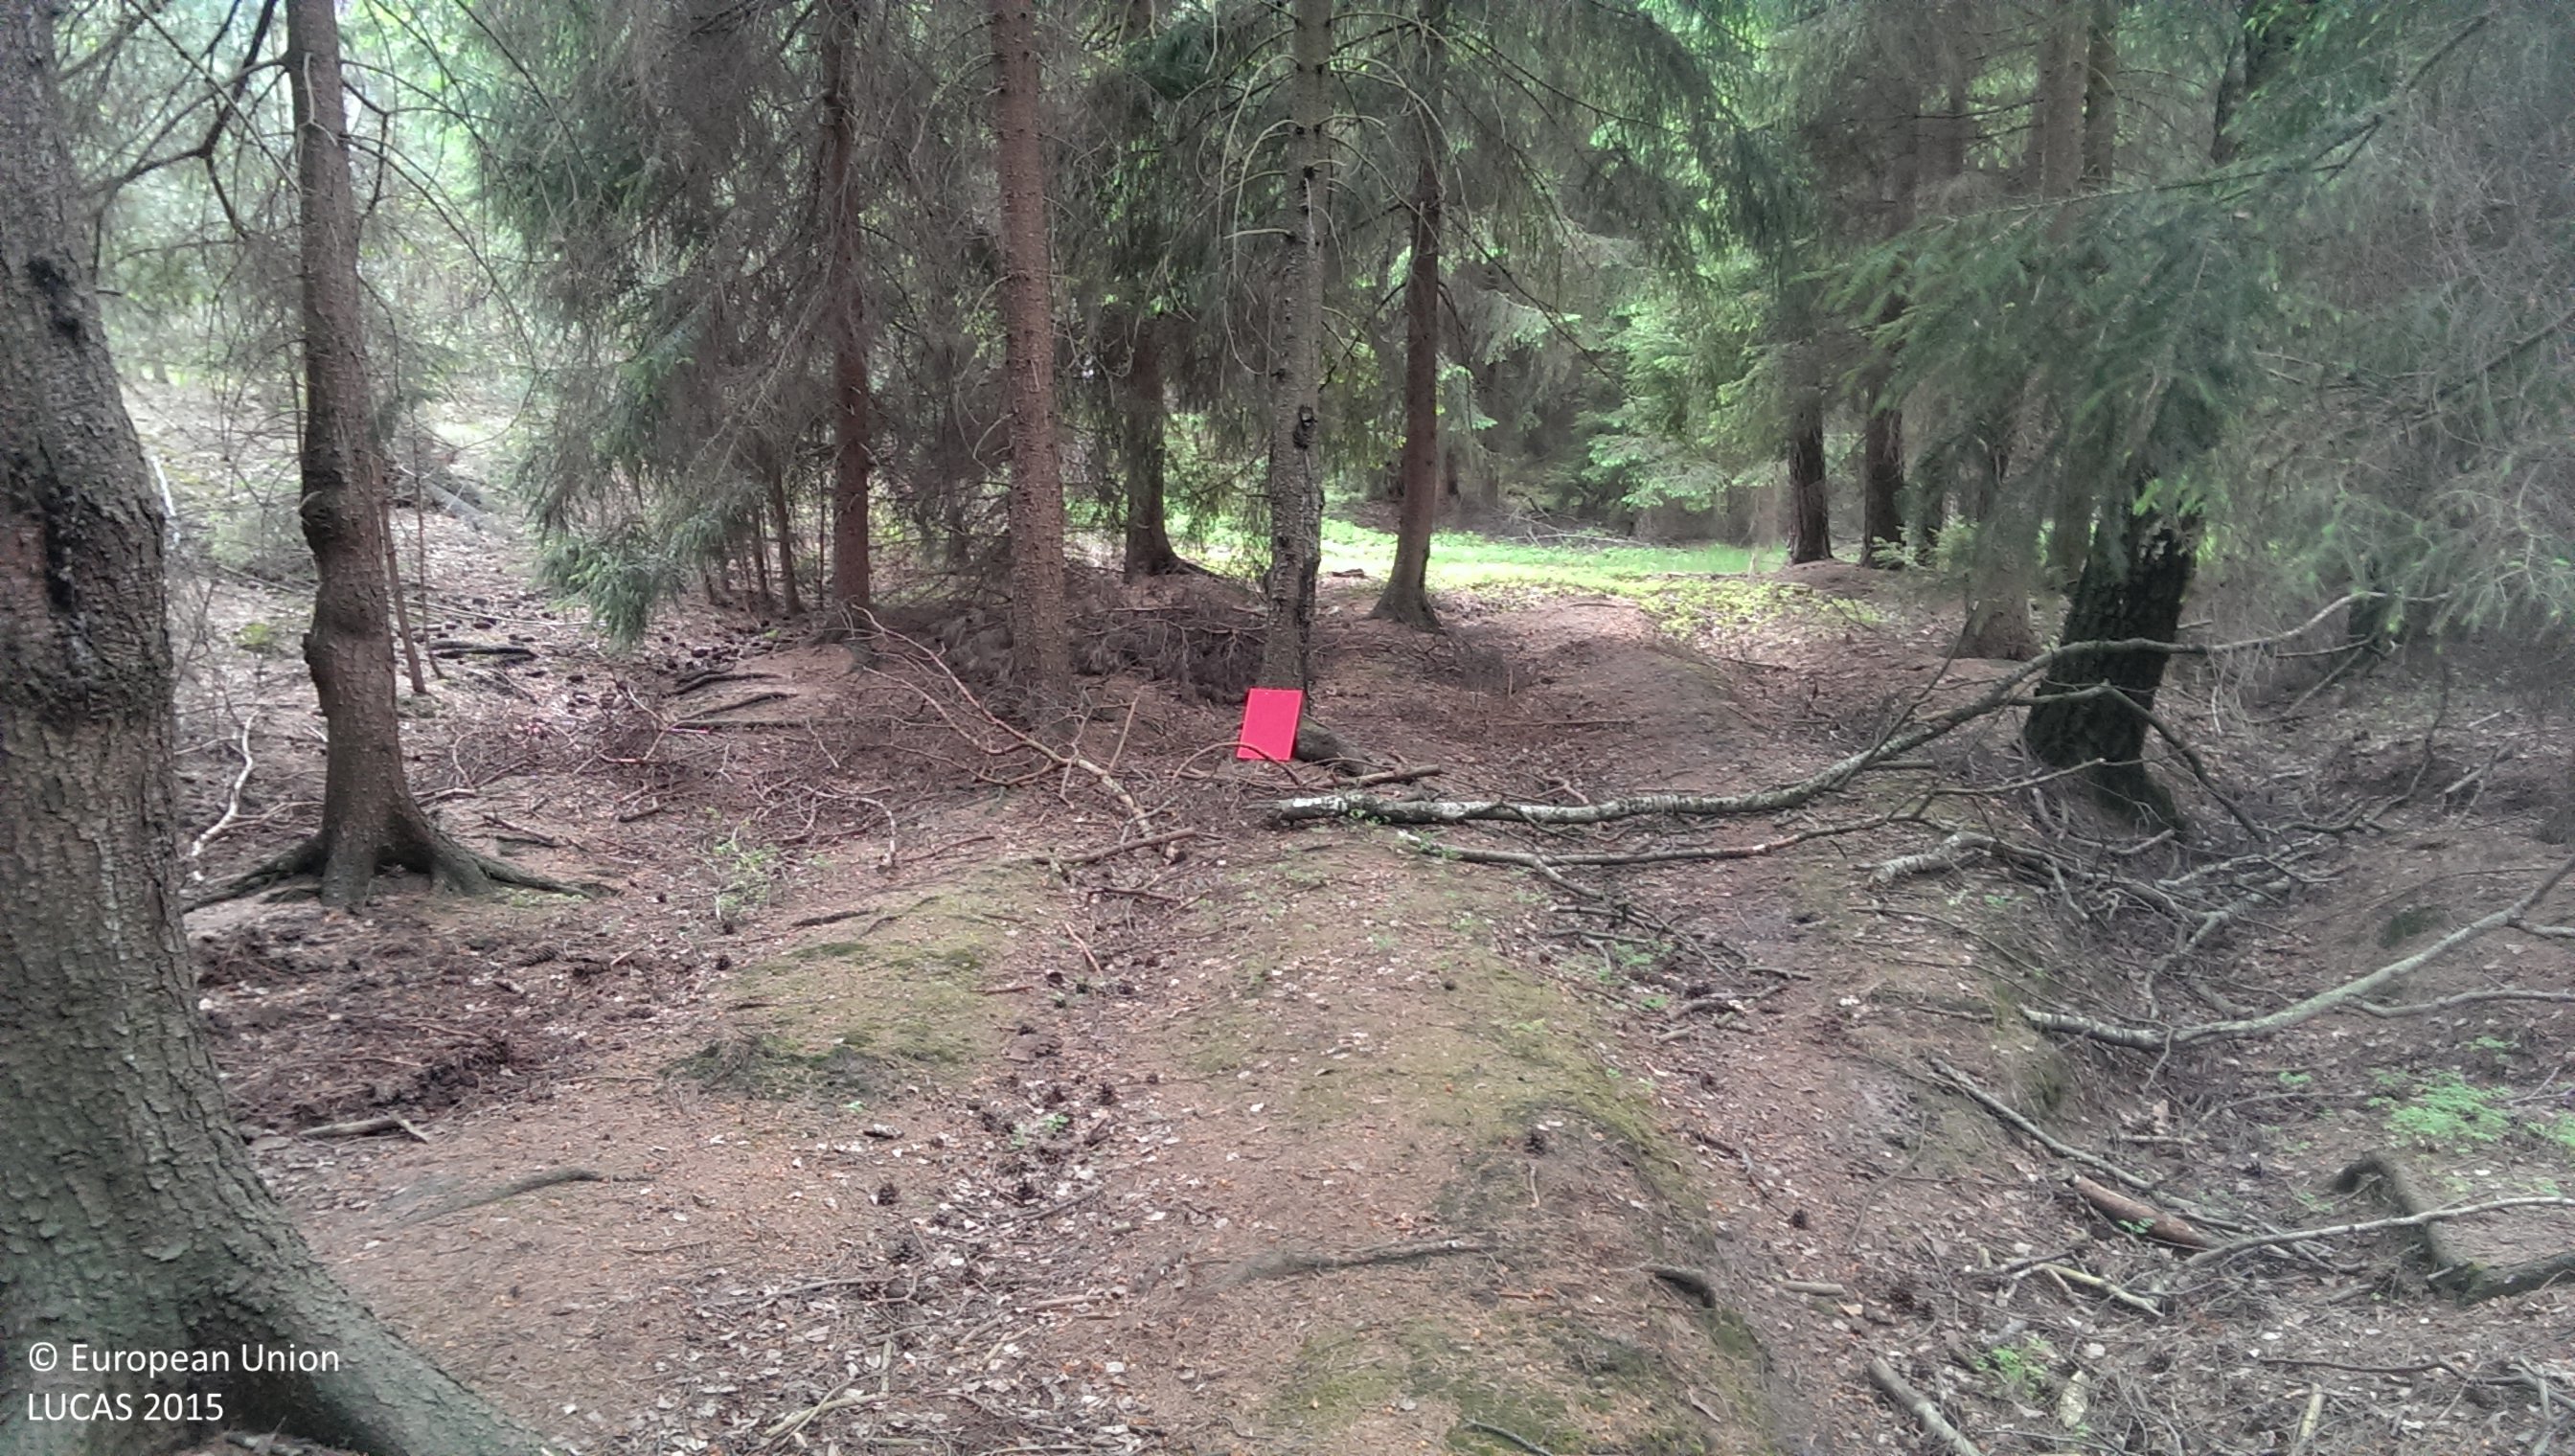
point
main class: Woodland
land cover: Spruce dominated coniferous woodland
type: hemiboreal forest and nemoral coniferous forest and mixed broadleaved-coniferous forest
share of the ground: > 75 %
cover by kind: coniferous forest trees 75 %, lichens and mosses 25 %
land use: Forestry
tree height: > 5 m
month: May
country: PL
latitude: 52.2841
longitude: 16.2660
